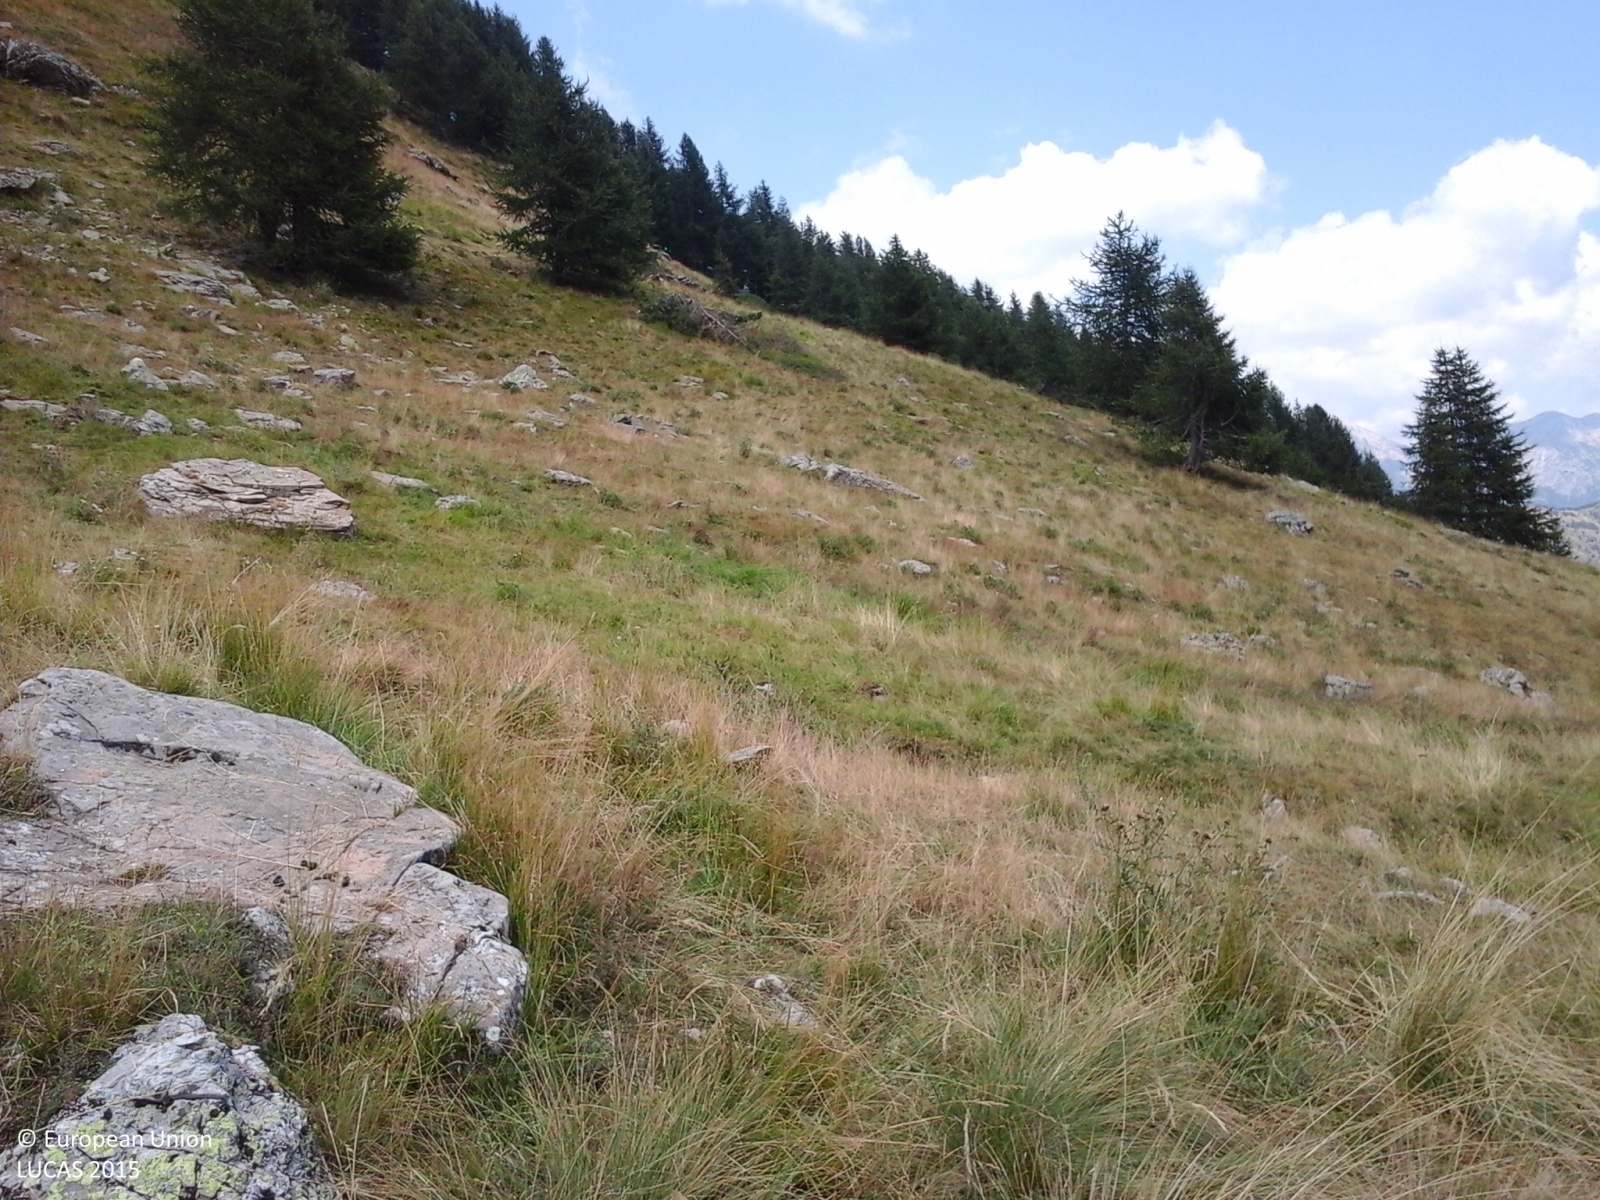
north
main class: Grassland
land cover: Grassland without tree/shrub cover
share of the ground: > 75 %
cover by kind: herbaceous plants 80 %, consolidated bare surface 20 %
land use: Agriculture (excluding fallow land and kitchen gardens)
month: August
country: IT
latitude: 44.0909
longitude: 7.7196
